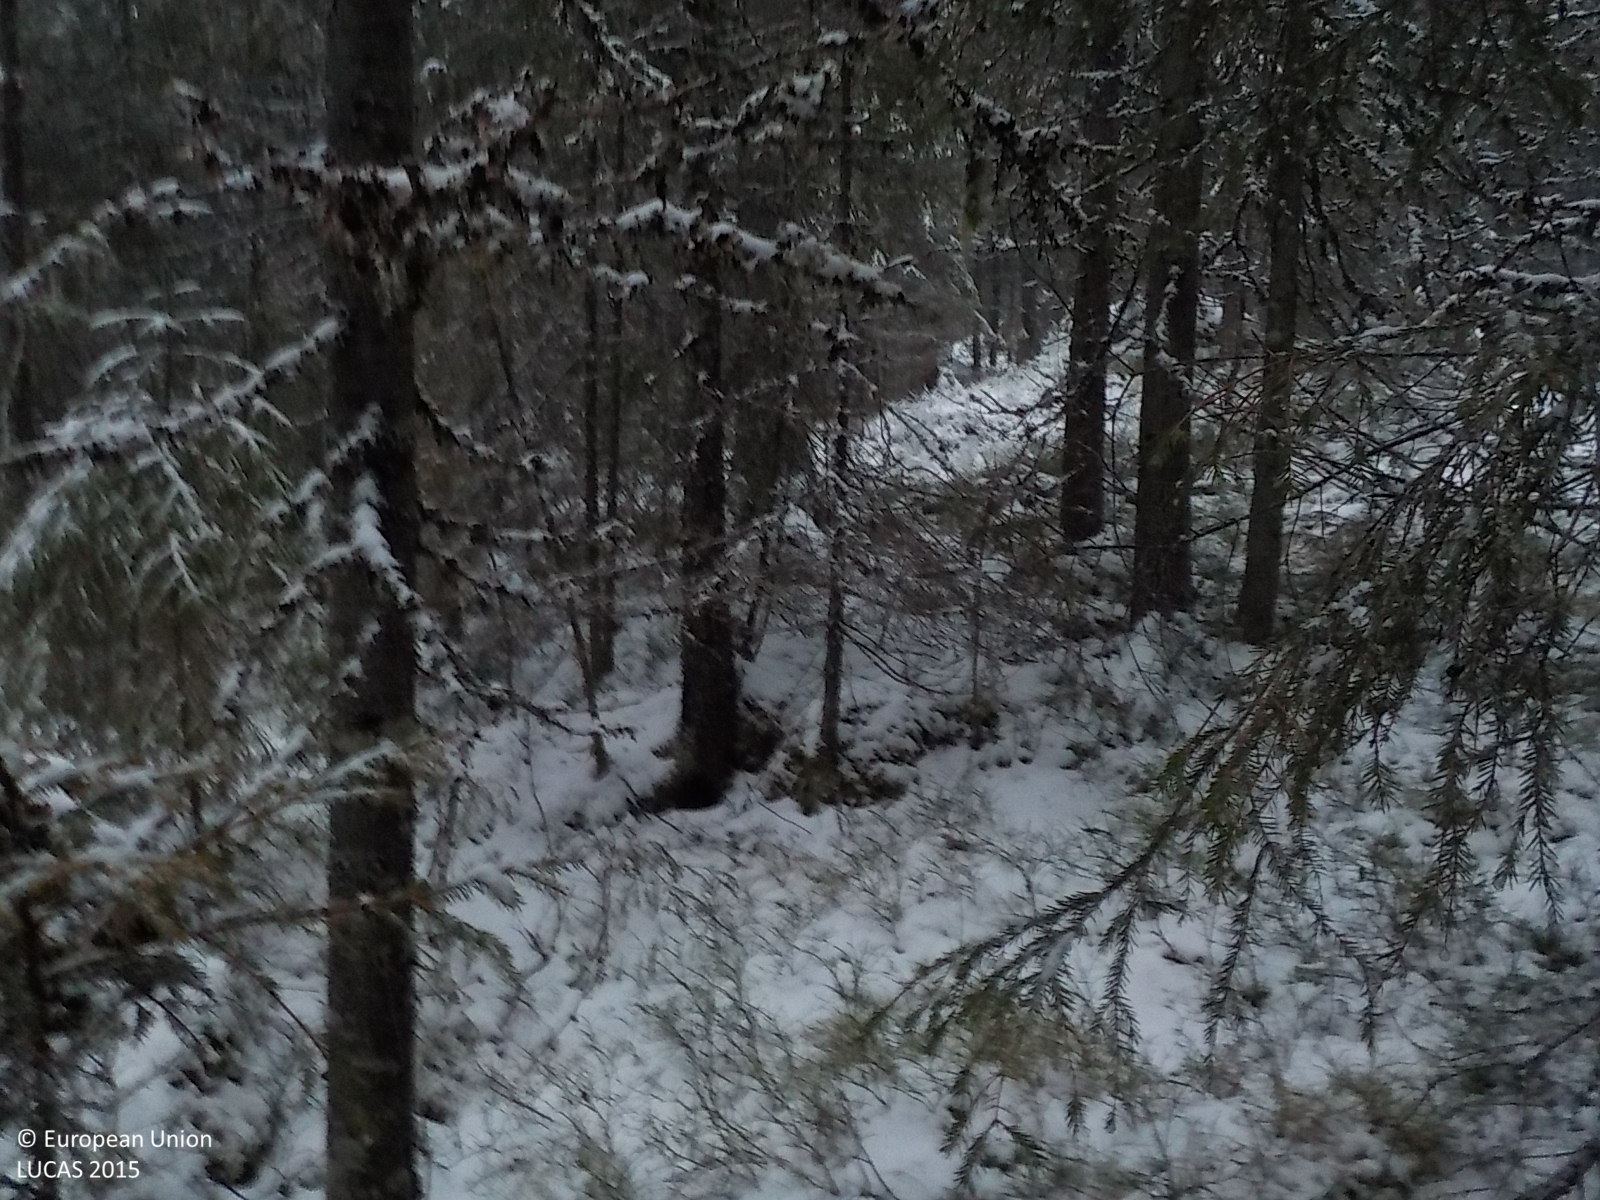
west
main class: Woodland
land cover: Spruce dominated coniferous woodland
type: boreal forest
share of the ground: > 75 %
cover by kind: coniferous forest trees 90 %, shrubs 5 %, lichens and mosses 5 %
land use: Forestry
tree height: > 5 m
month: December
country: SE
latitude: 63.2823
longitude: 17.0125
